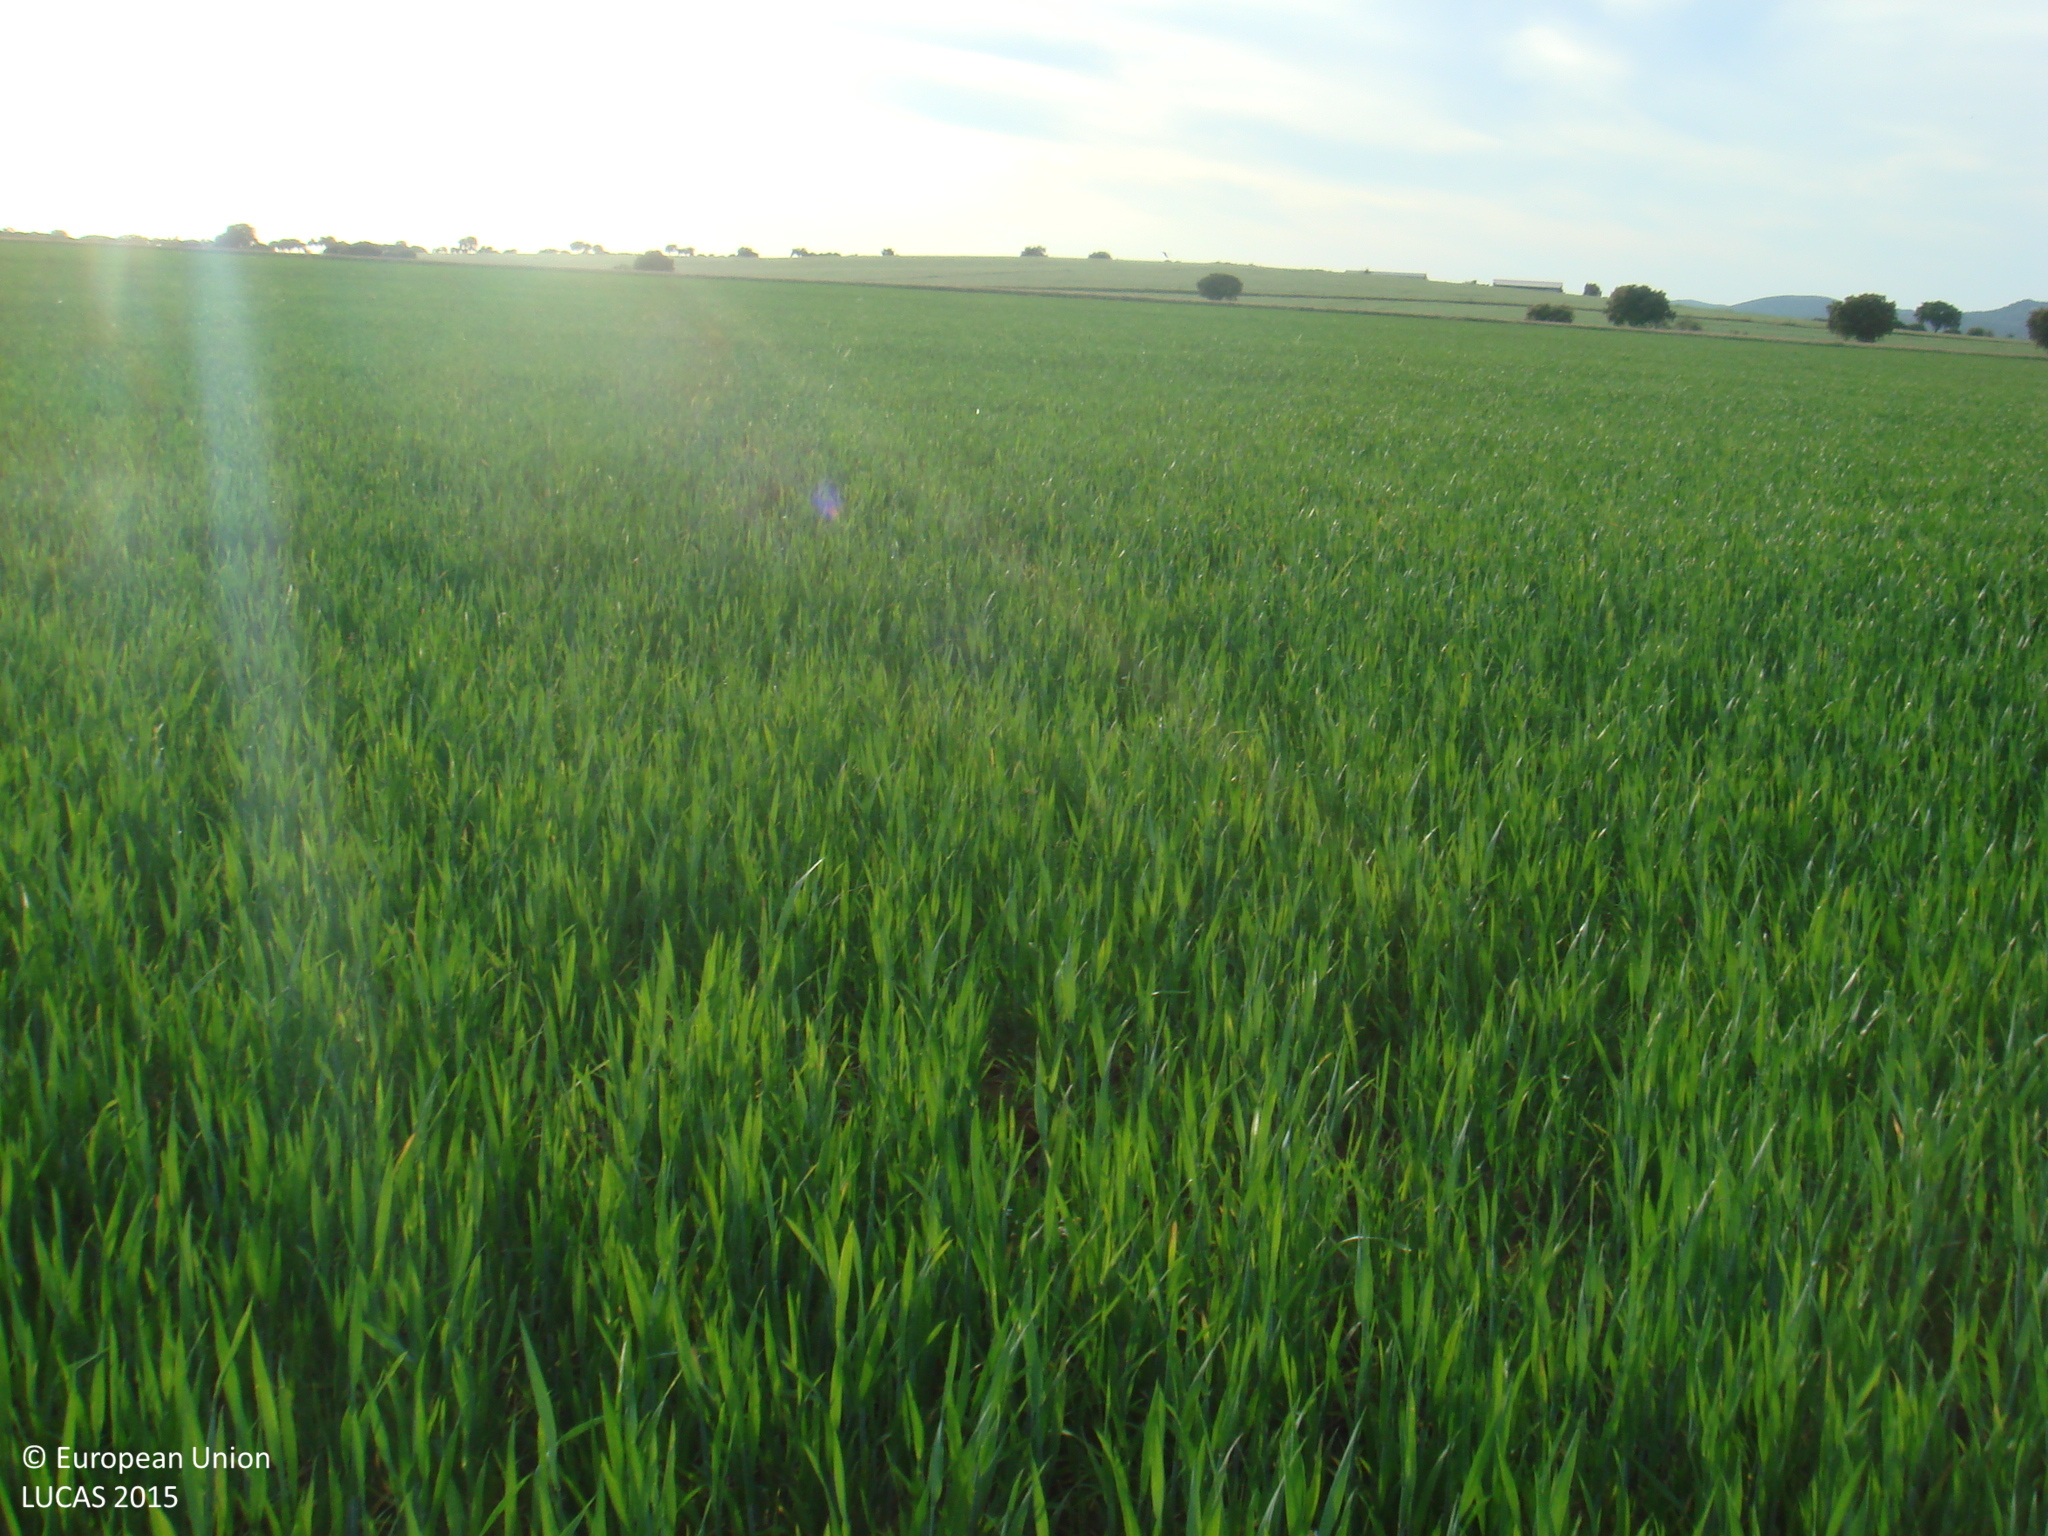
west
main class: Cropland
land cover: Durum wheat
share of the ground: > 75 %
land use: Agriculture (excluding fallow land and kitchen gardens)
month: April
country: ES
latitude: 38.3521
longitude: -5.3527
